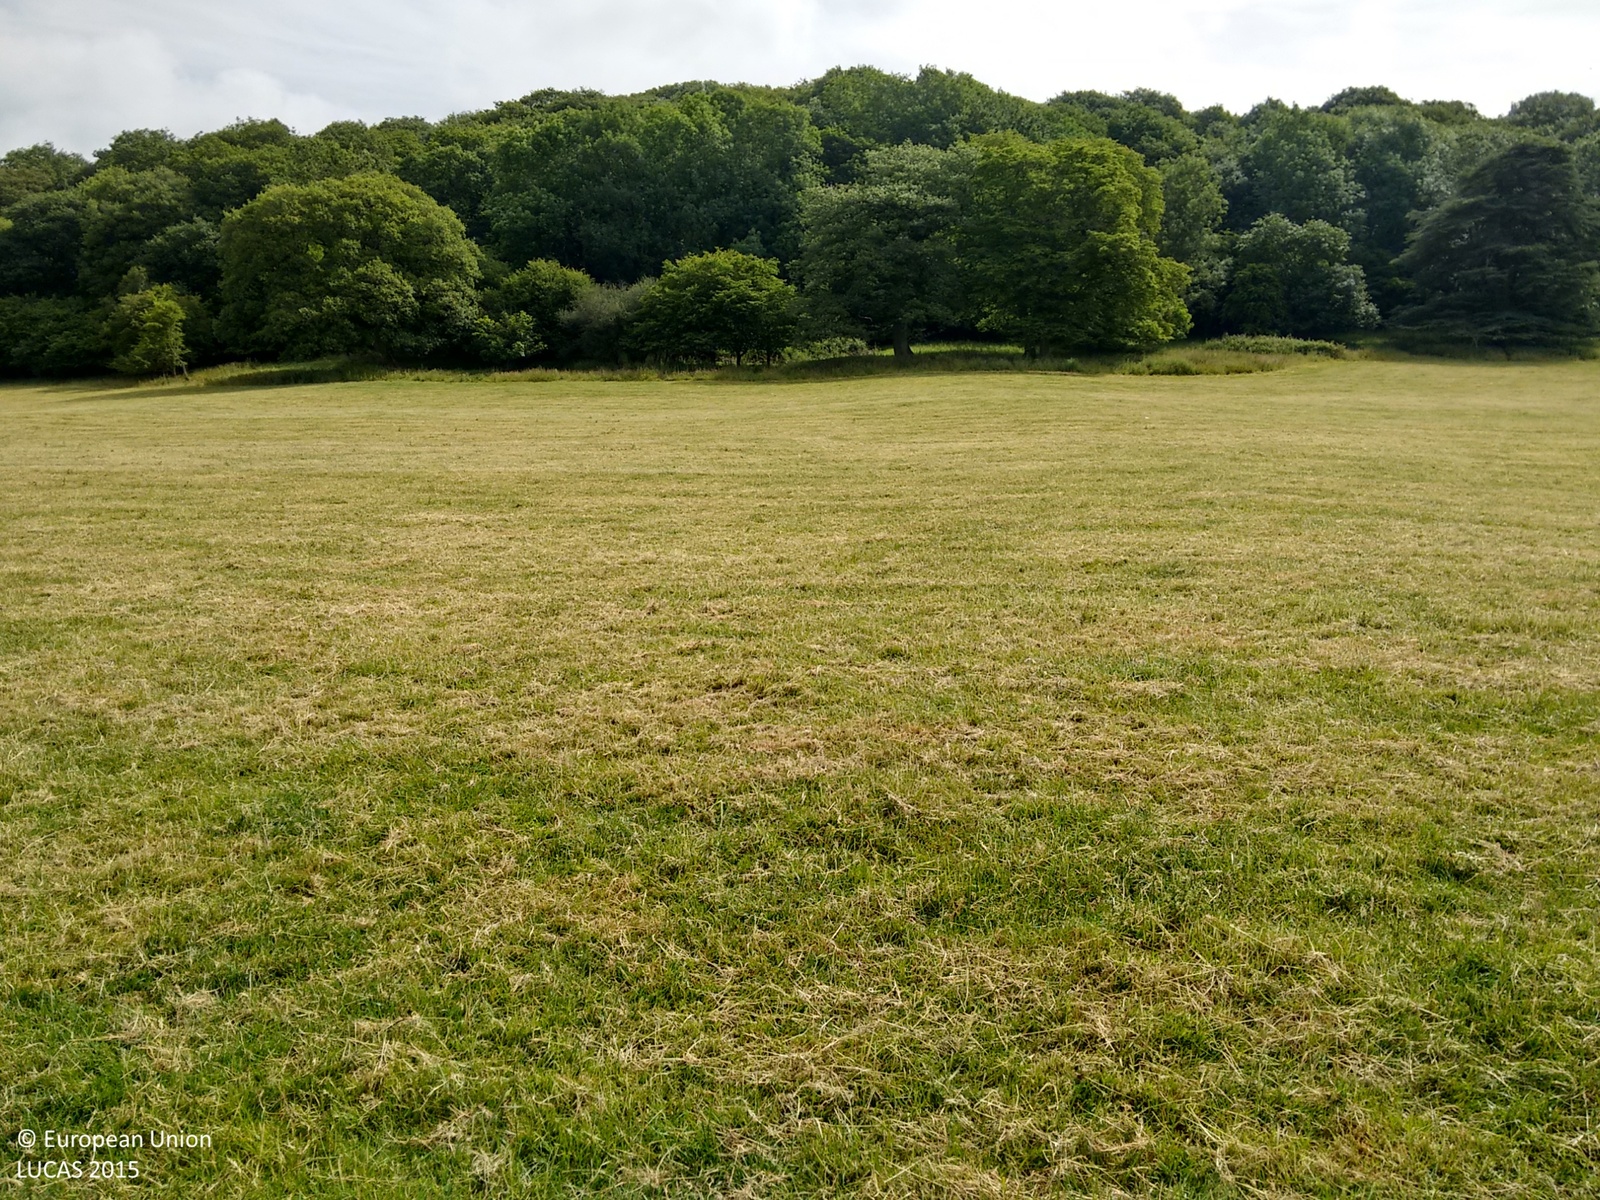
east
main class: Grassland
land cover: Grassland without tree/shrub cover
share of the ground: > 75 %
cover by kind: herbaceous plants 100 %
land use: Agriculture (excluding fallow land and kitchen gardens)
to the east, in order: Grassland without tree/shrub cover; Broadleaved woodland; Tracks; Fences; Broadleaved woodland
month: June
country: GB
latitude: 52.3370
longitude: -2.7959
